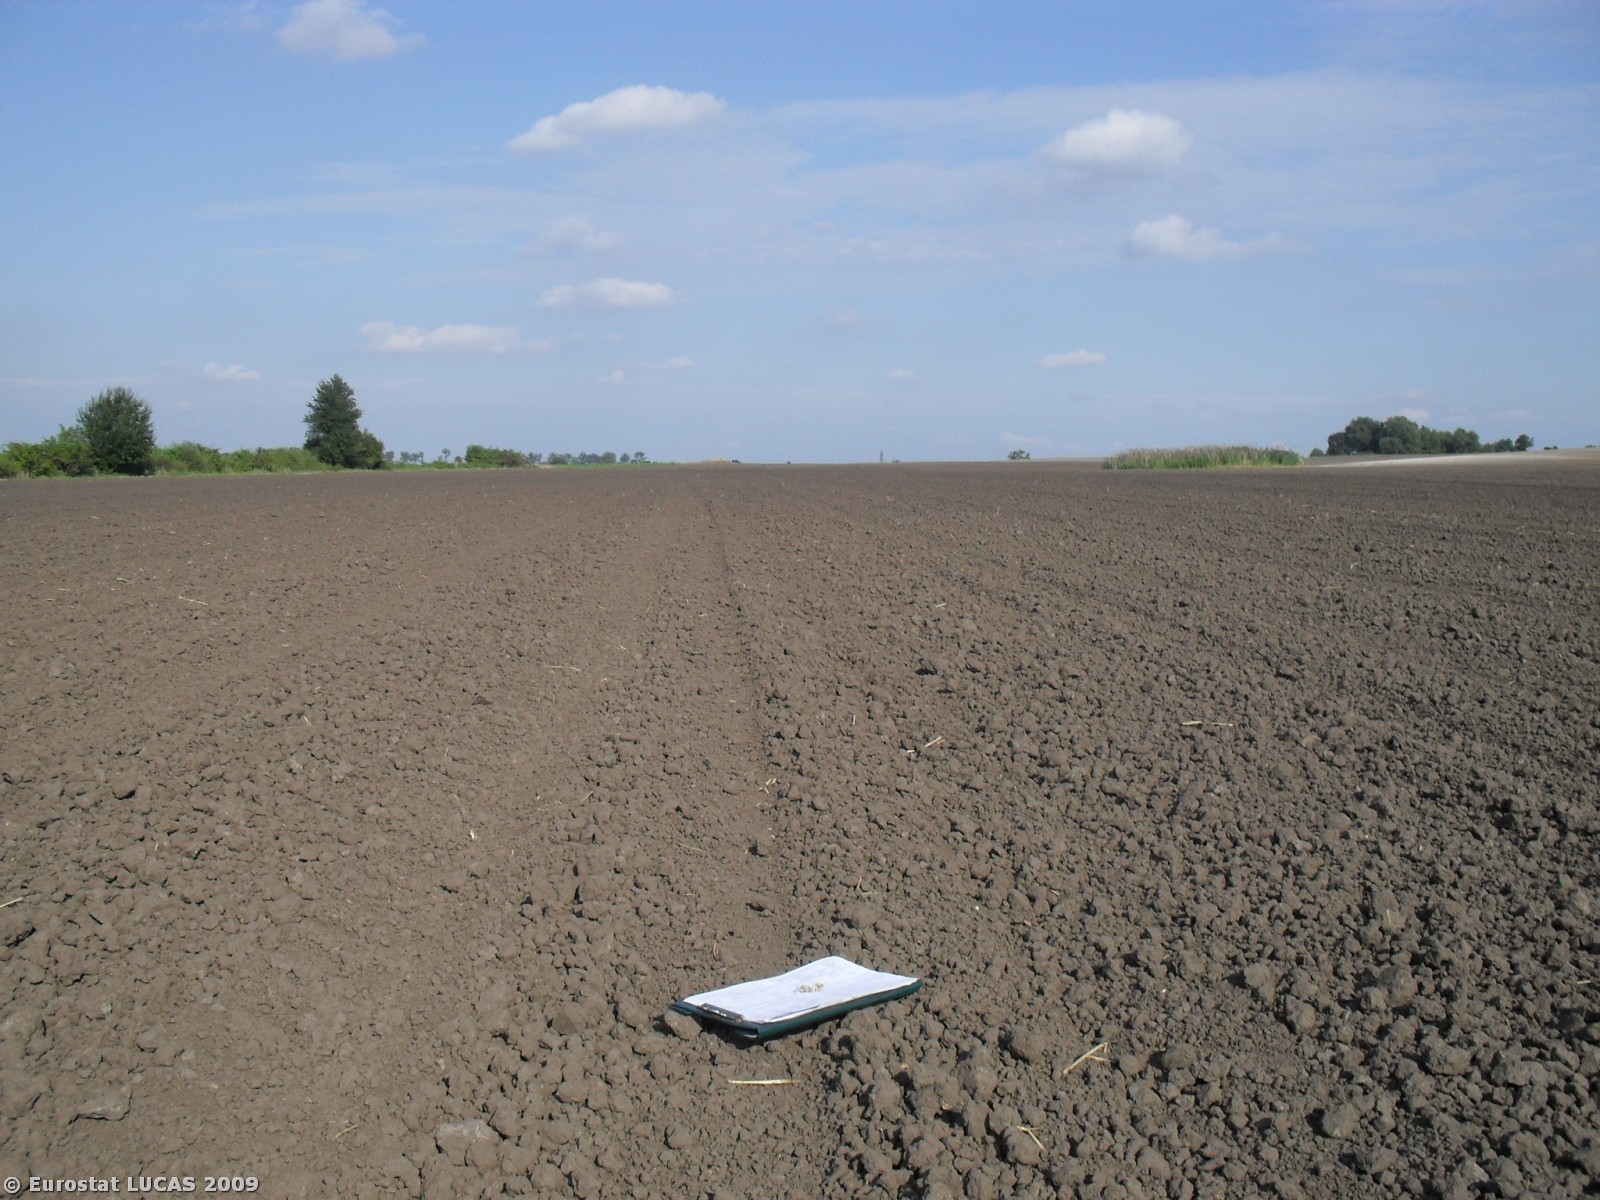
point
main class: Cropland
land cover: Common wheat
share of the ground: < 10 %
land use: Agriculture (excluding fallow land and kitchen gardens)
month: September
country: PL
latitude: 50.8208
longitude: 17.2365
